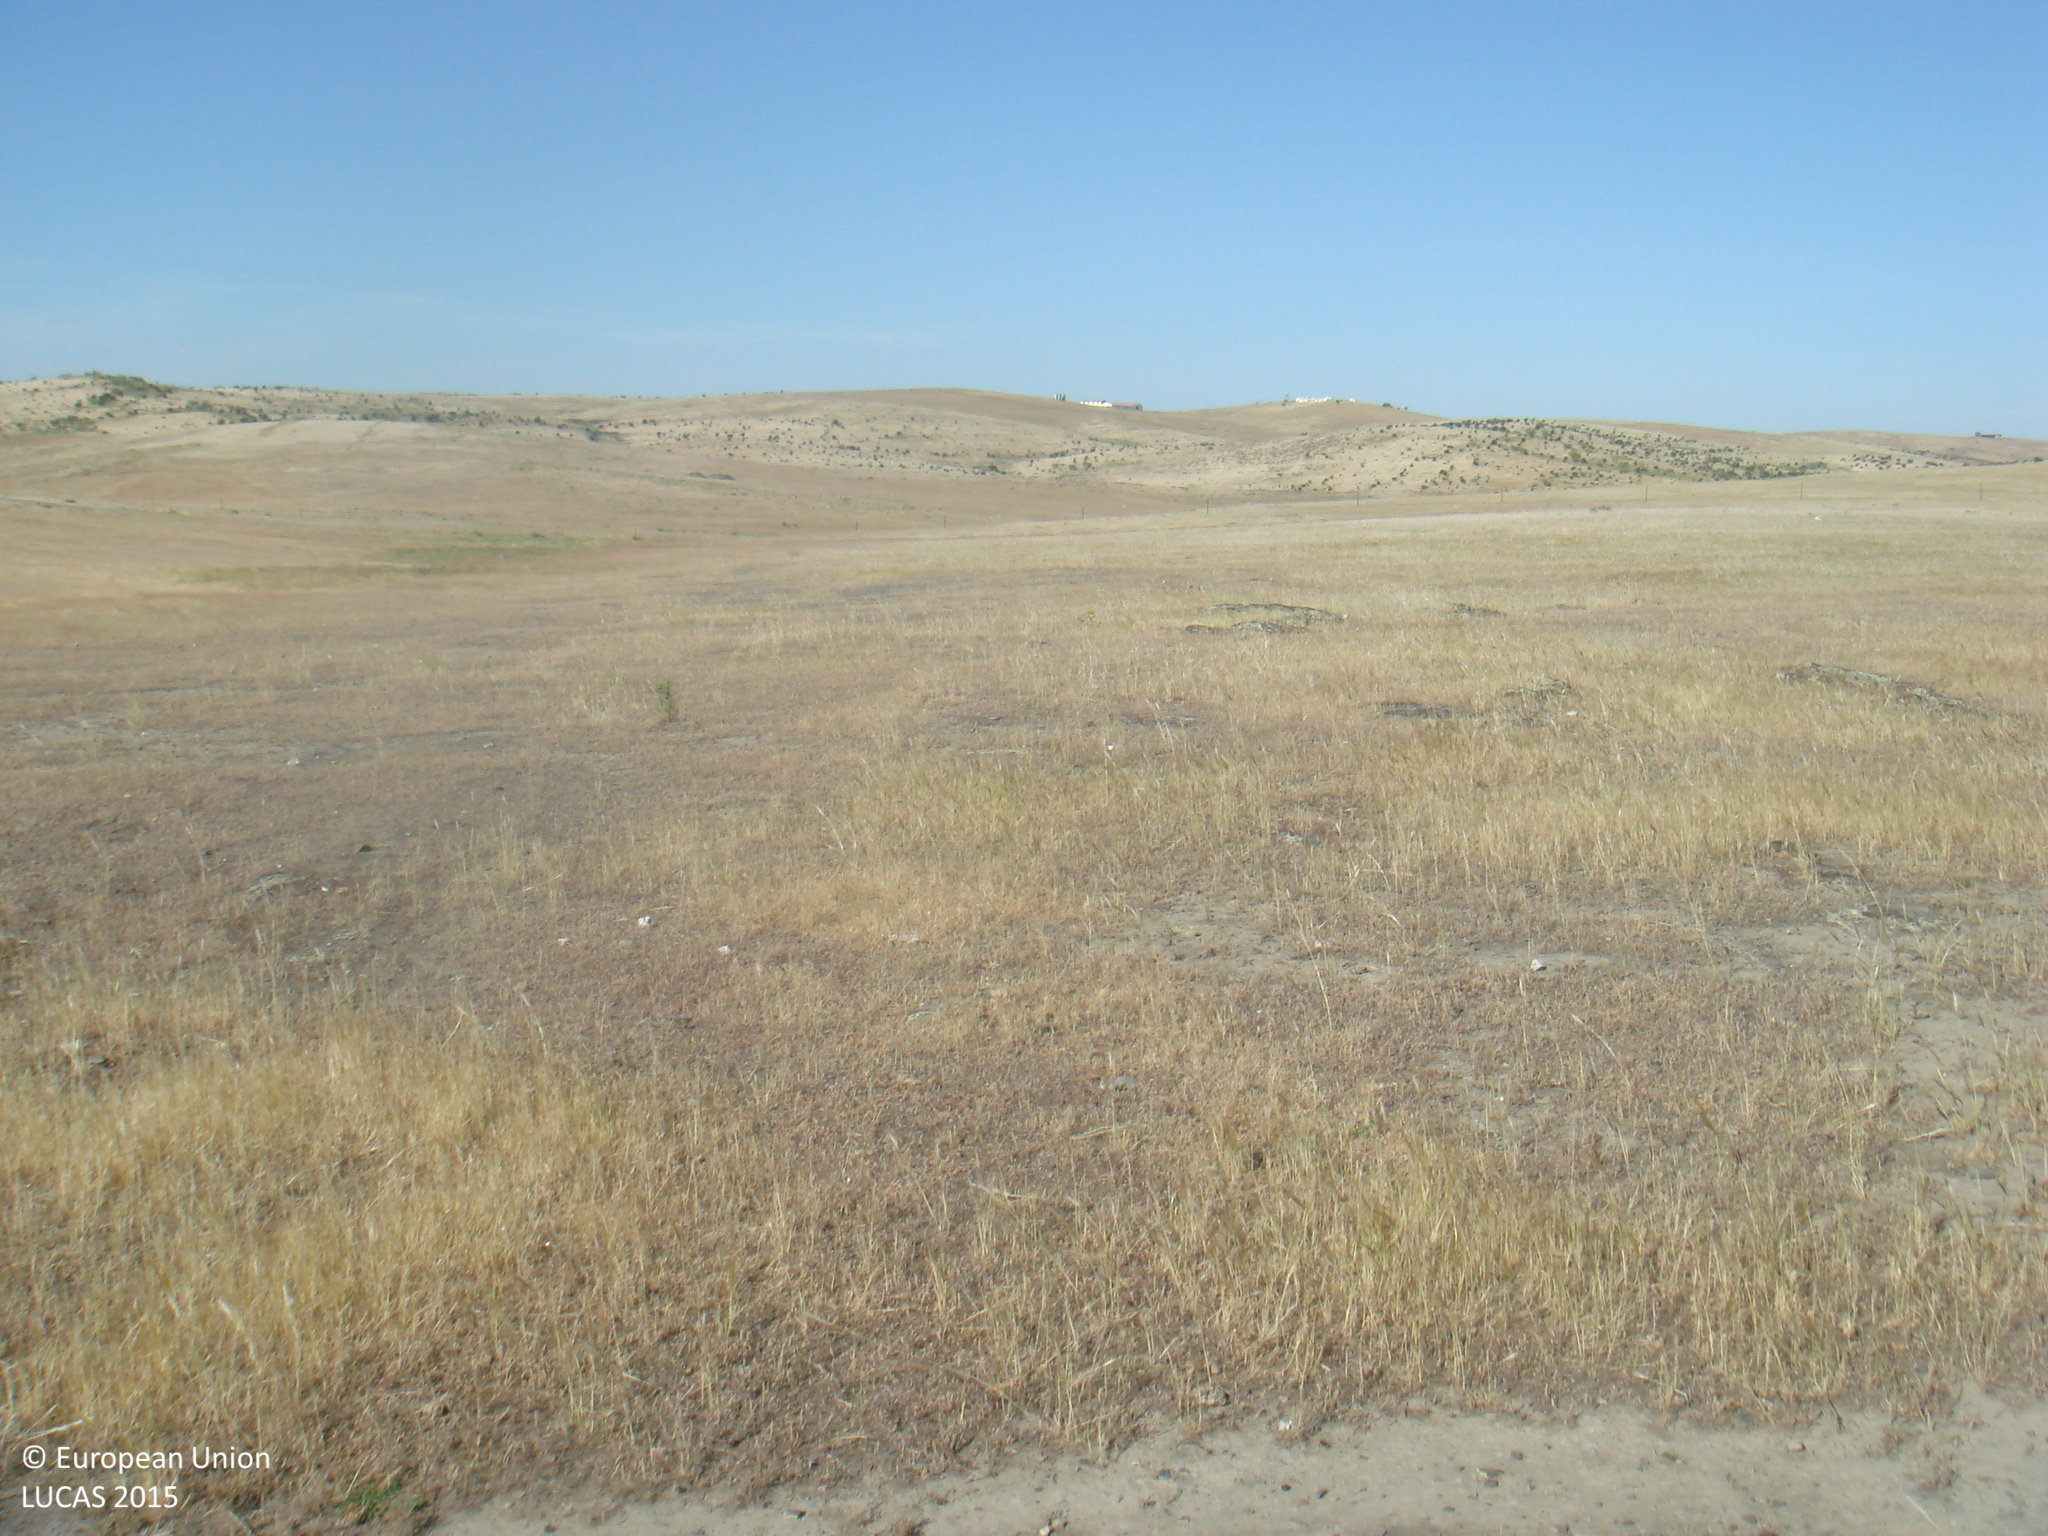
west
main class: Grassland
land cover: Spontaneously vegetated surfaces
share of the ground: > 75 %
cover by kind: herbaceous plants 100 %
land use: Agriculture (excluding fallow land and kitchen gardens)
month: May
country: ES
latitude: 38.5975
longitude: -5.0832
